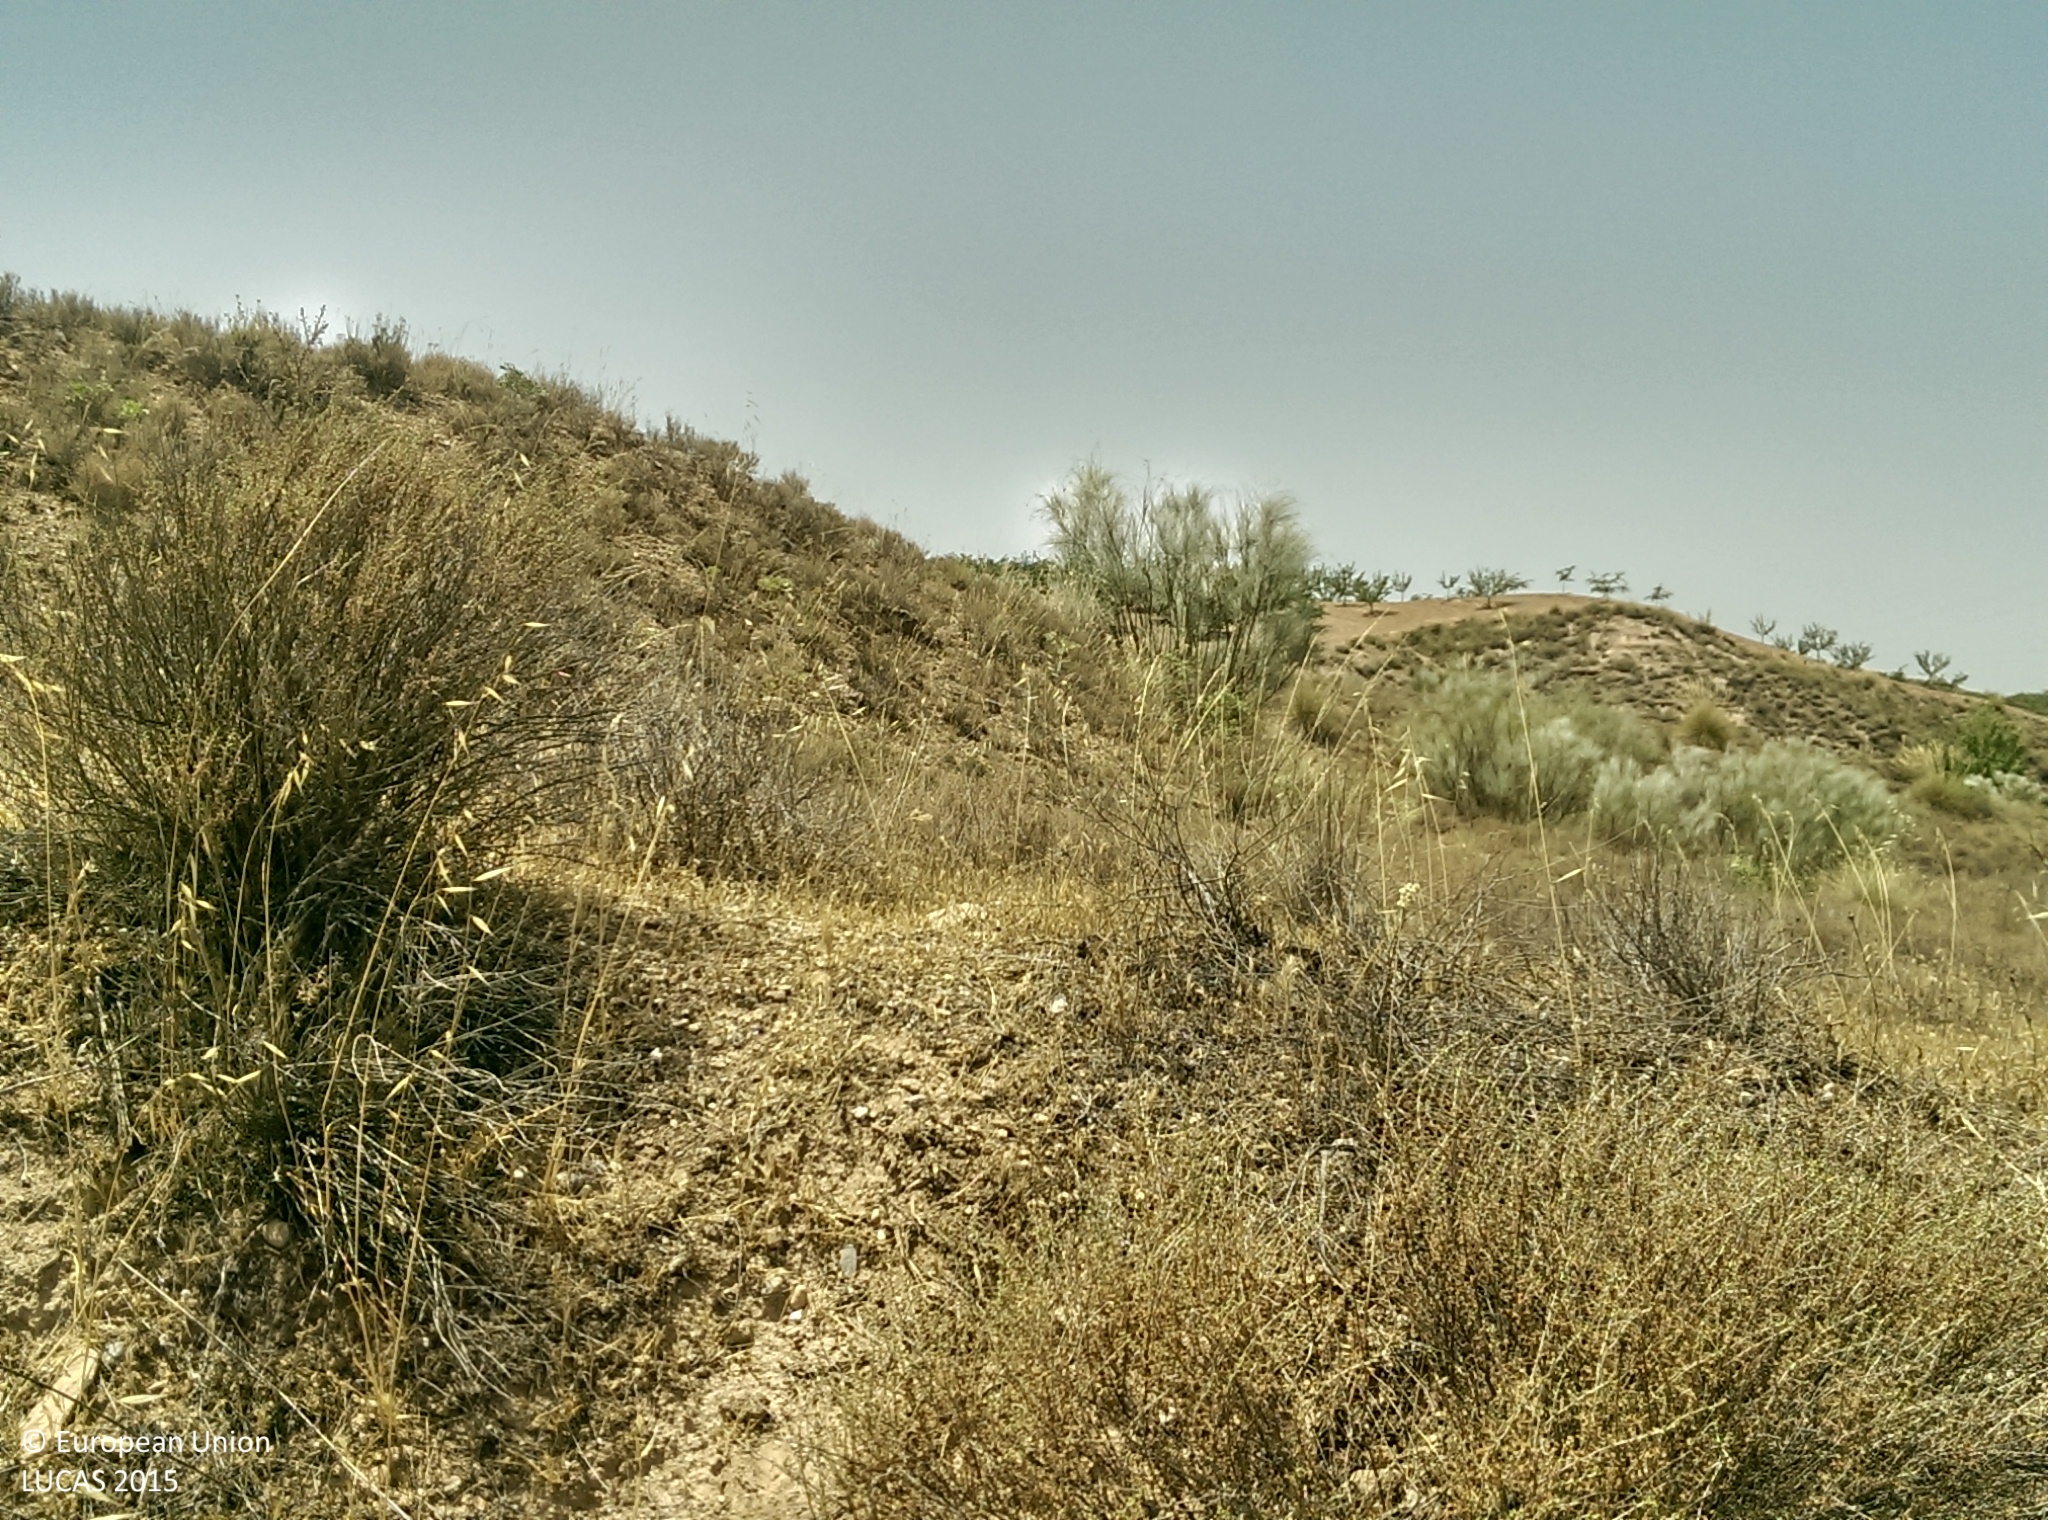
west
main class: Shrubland
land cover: Shrubland with sparse tree cover
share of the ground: 50 - 75 %
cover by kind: shrubs 55 %, herbaceous plants 30 %, unconsolidated bare surface 10 %, coniferous forest trees 5 %
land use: Abandoned areas
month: July
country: ES
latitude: 37.5283
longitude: -2.8771
